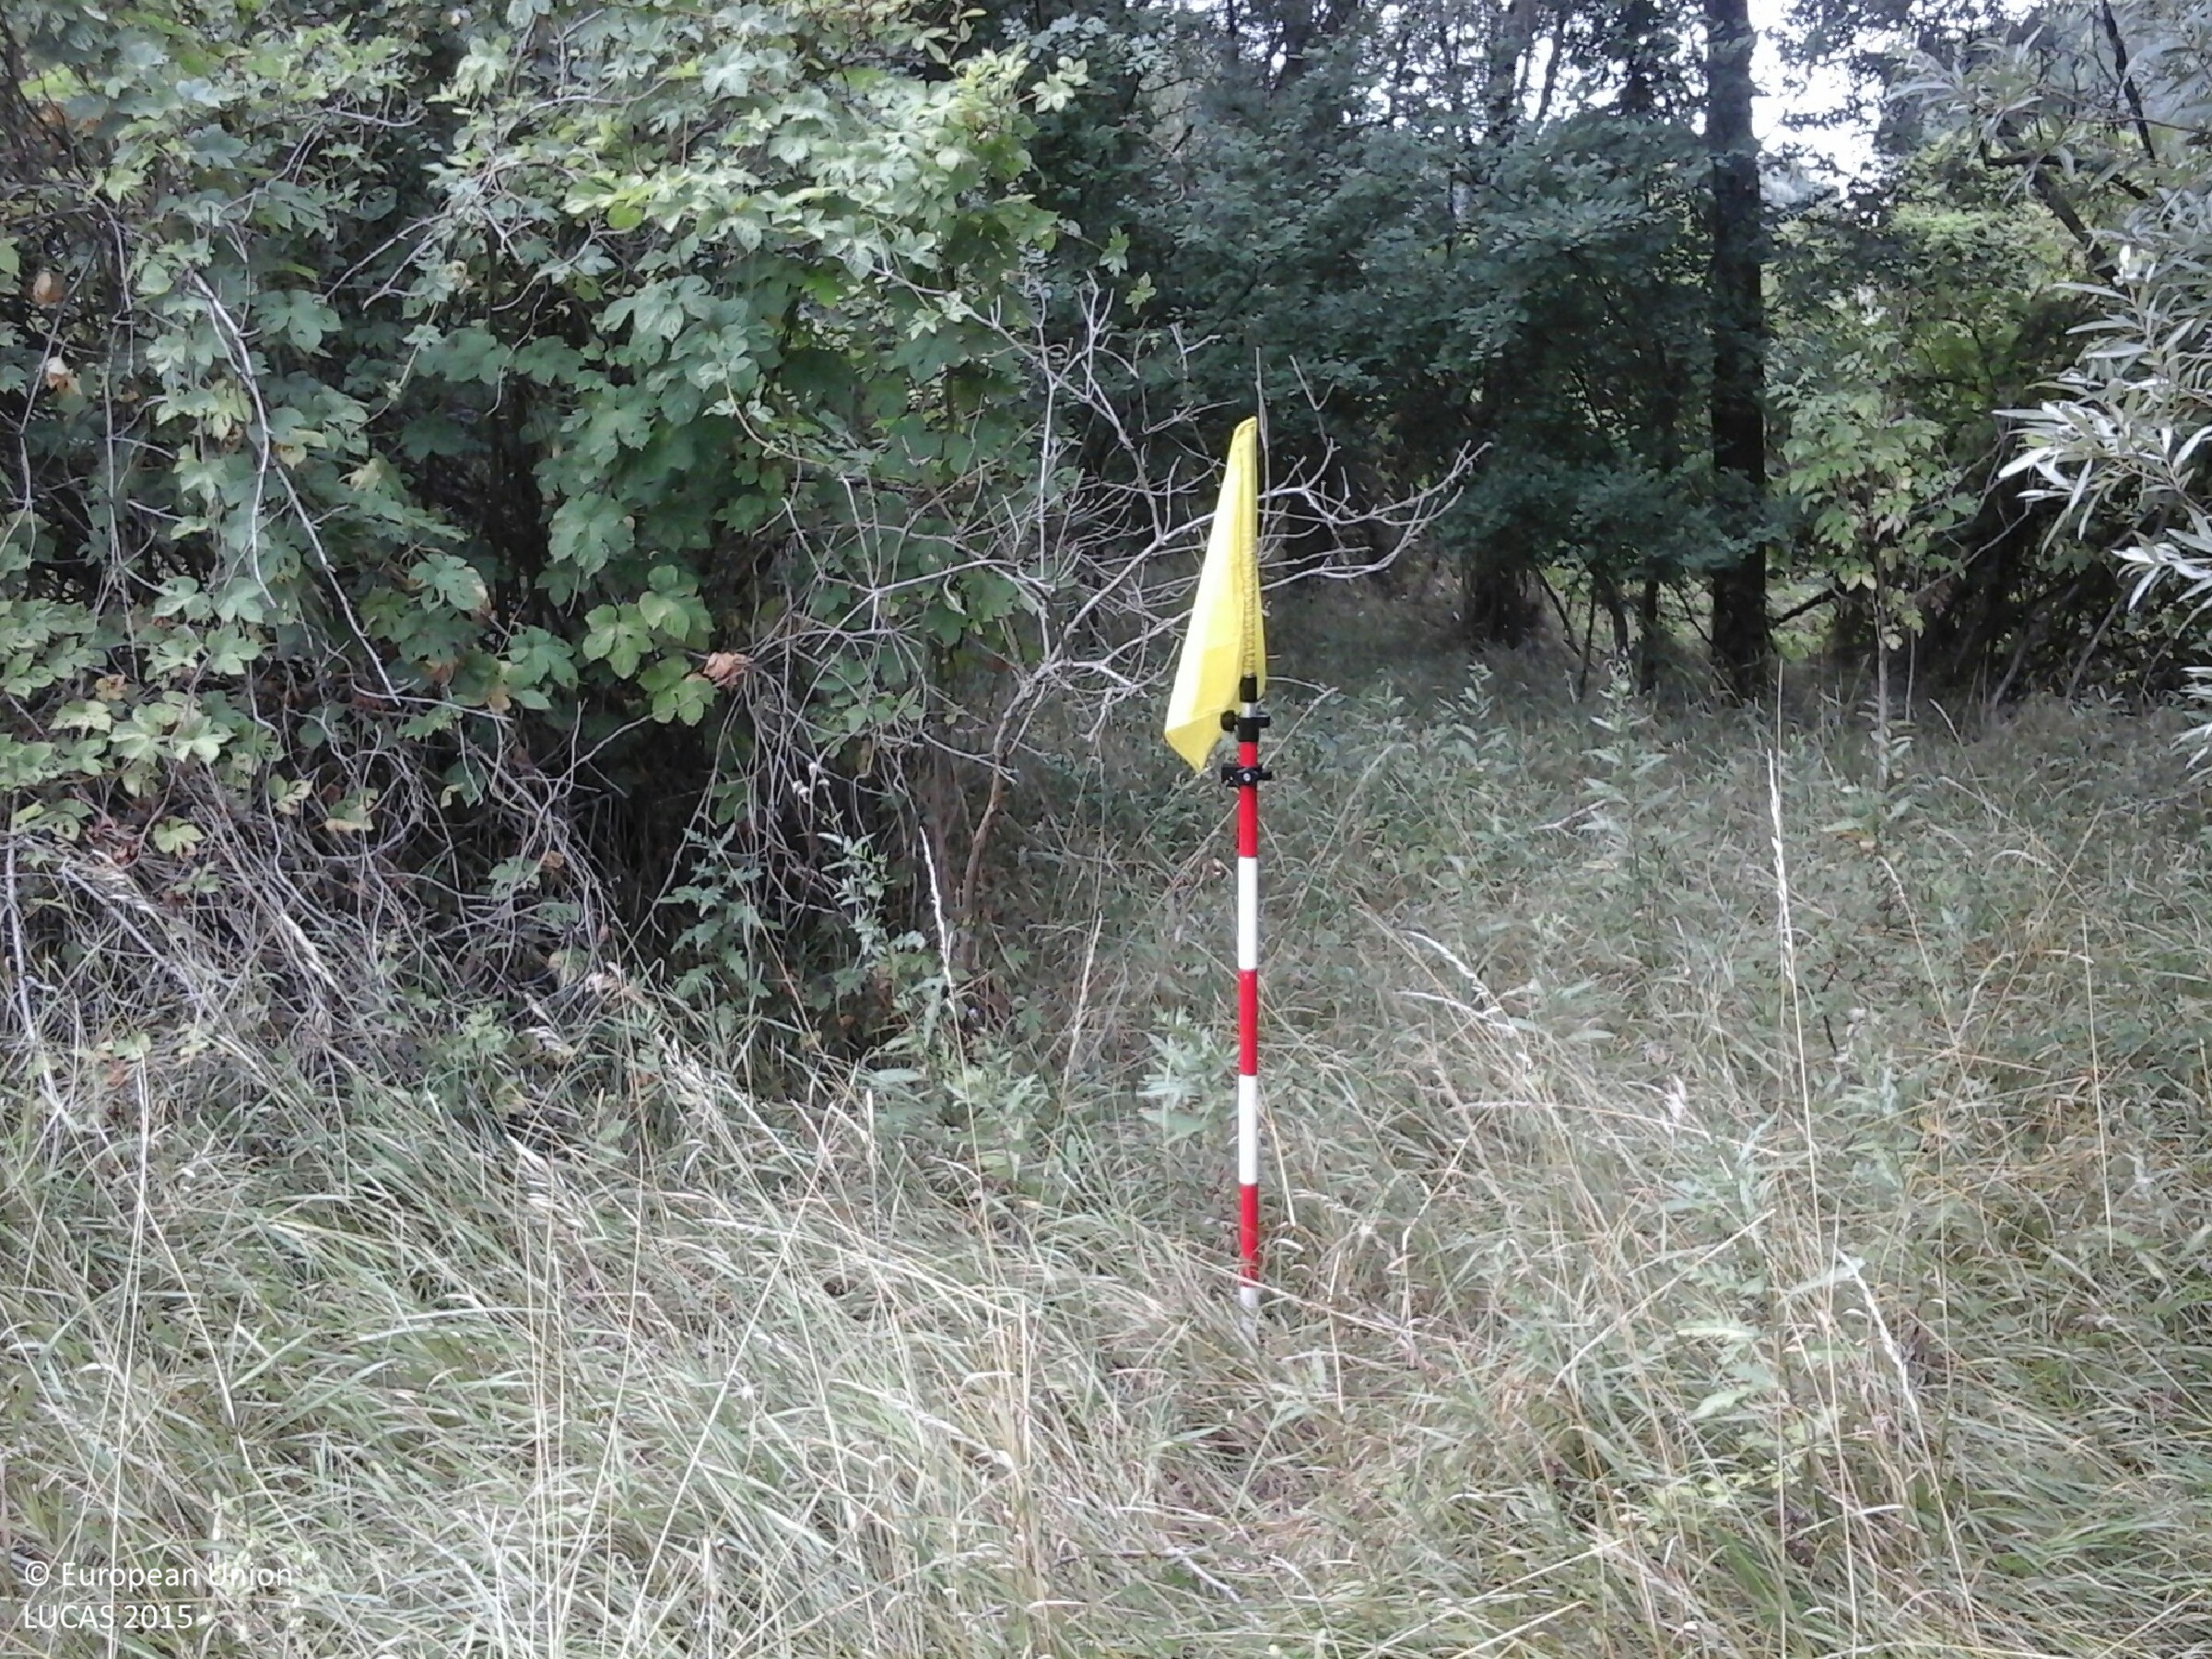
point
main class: Woodland
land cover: Broadleaved woodland
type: mesophytic deciduous forest
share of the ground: 50 - 75 %
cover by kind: broadleaved forest trees 70 %, herbaceous plants 30 %
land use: Forestry
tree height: > 5 m
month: July
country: HU
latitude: 47.5277
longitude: 20.6183
